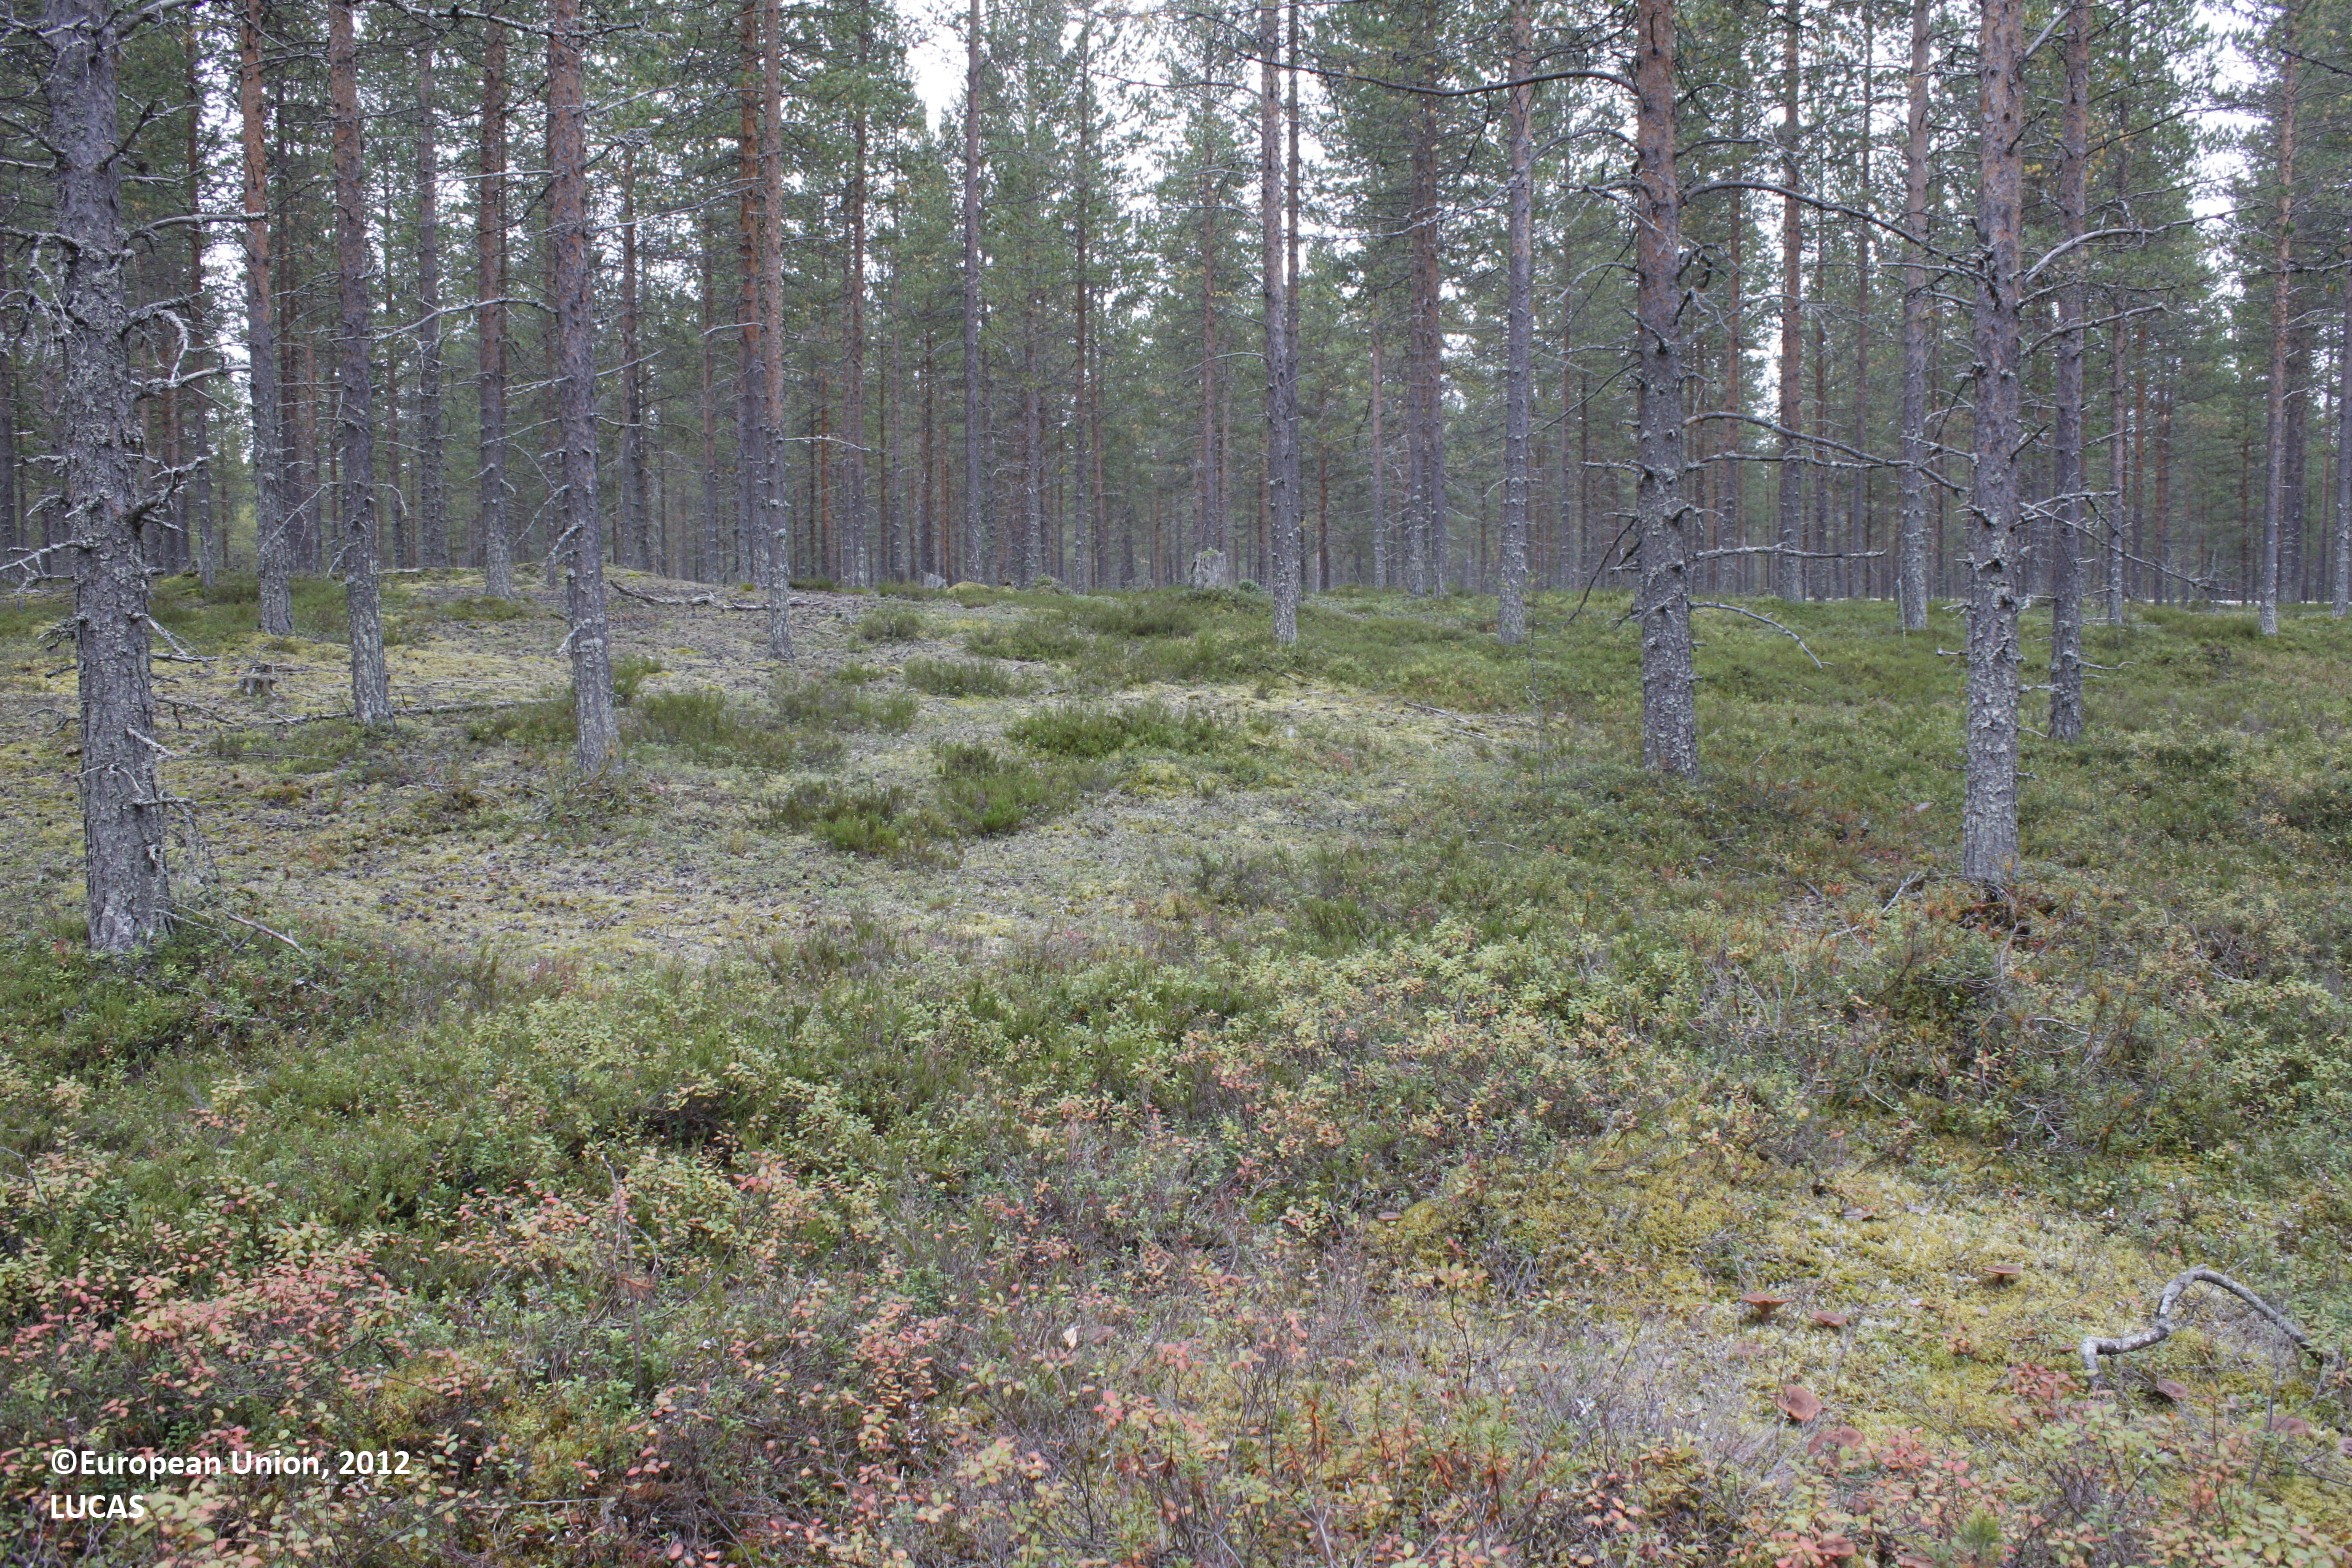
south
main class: Woodland
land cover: Pine dominated coniferous woodland
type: mire and swamp forests
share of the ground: 25 - 50 %
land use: Forestry
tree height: > 5 m
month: September
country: FI
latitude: 65.4316
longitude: 26.5499
